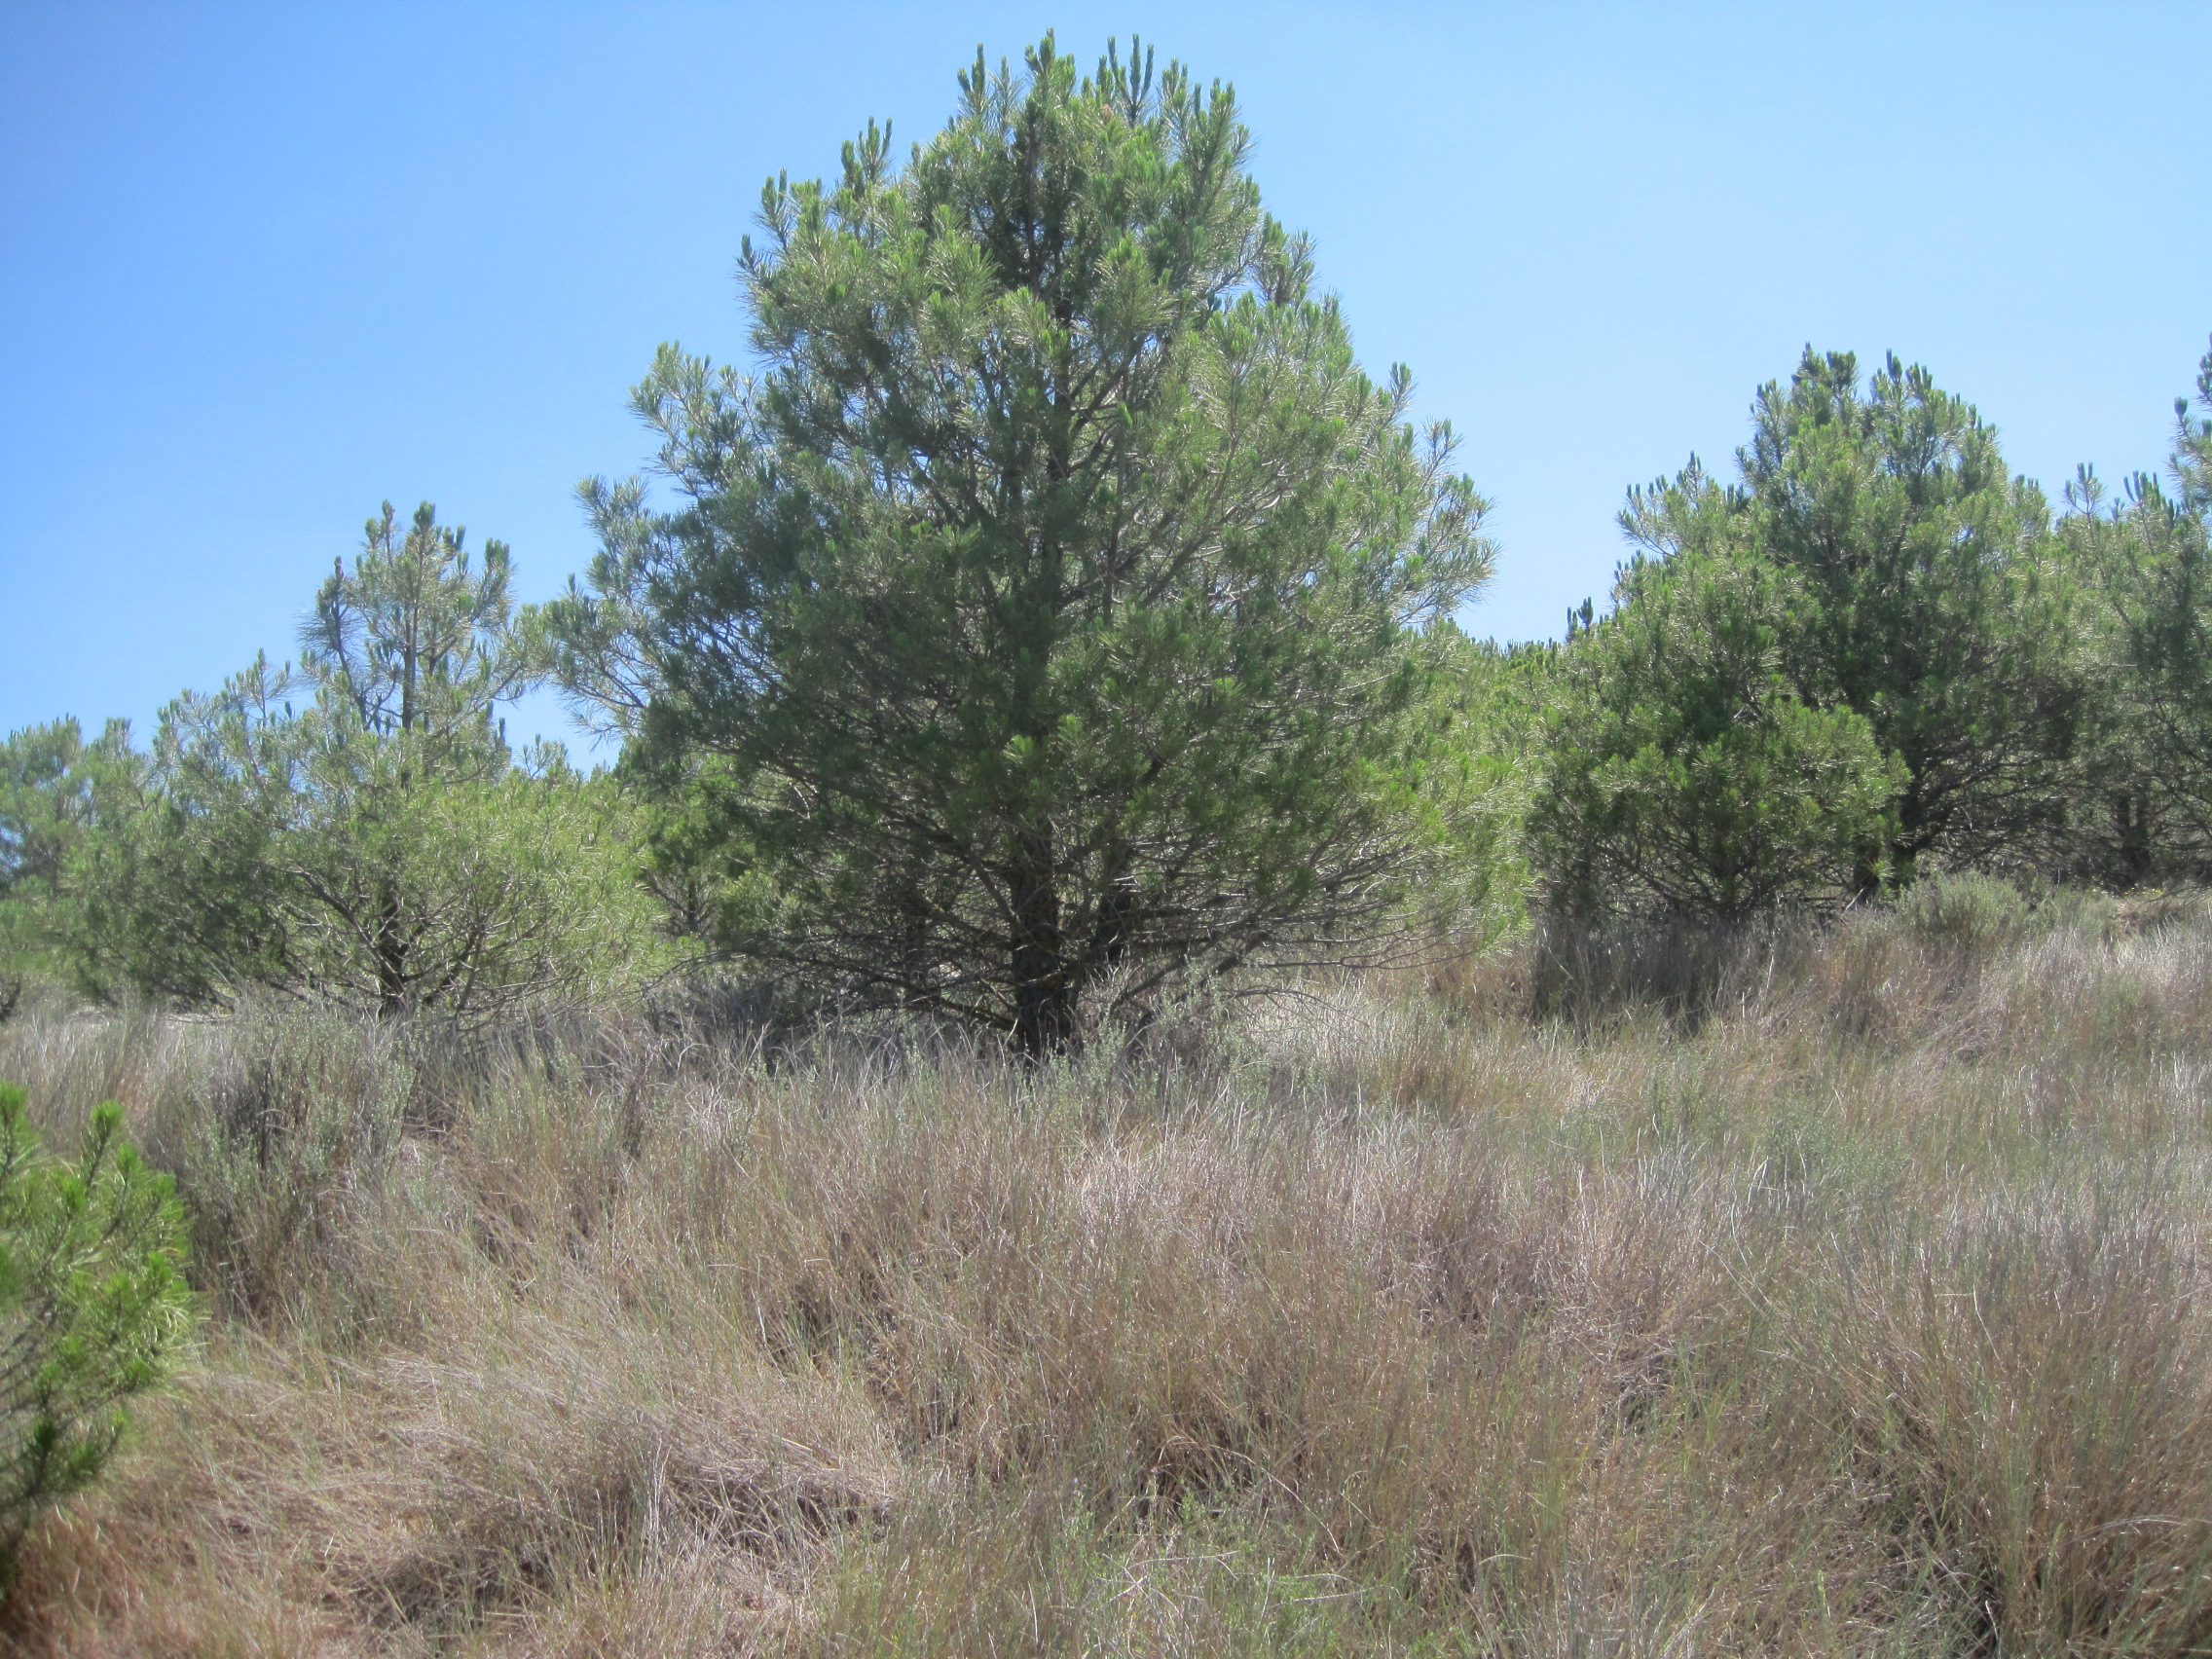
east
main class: Woodland
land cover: Pine dominated coniferous woodland
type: coniferous forest of the mediterranean region
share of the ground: 25 - 50 %
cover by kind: herbaceous plants 60 %, coniferous forest trees 40 %
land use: Semi-natural and natural areas not in use
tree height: > 5 m
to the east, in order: Pine dominated coniferous woodland; Grassland without tree/shrub cover; Barley; Pine dominated coniferous woodland; Grassland with sparse tree/shrub cover
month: July
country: ES
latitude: 41.9621
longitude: -4.6837
